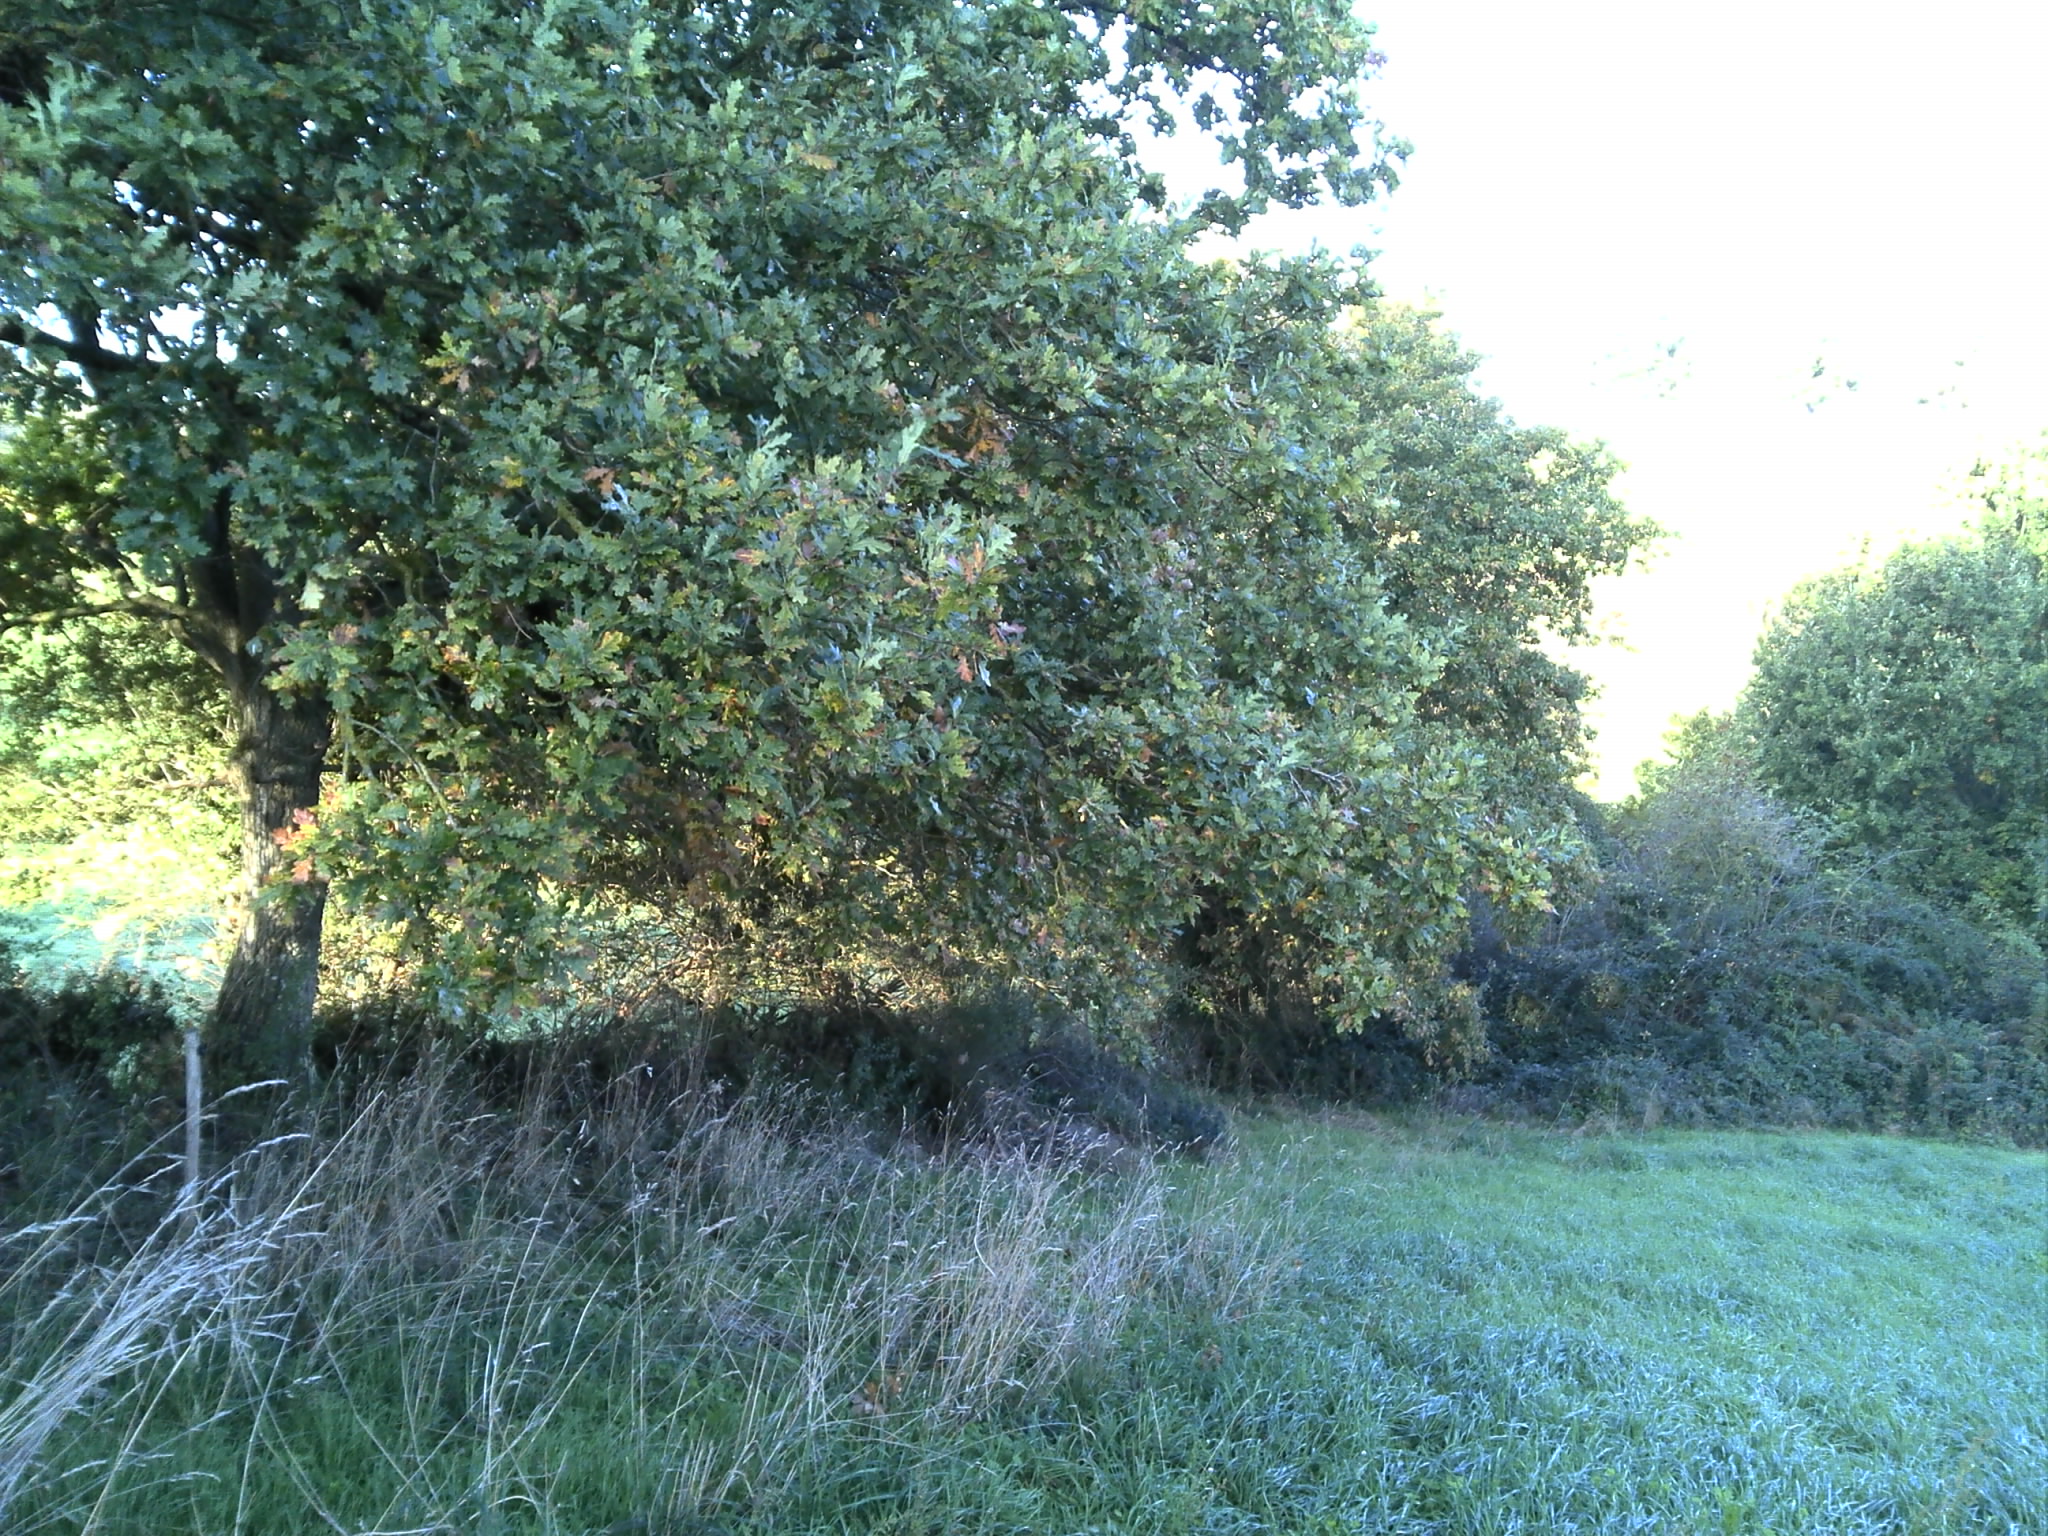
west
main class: Grassland
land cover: Grassland without tree/shrub cover
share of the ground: > 75 %
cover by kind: herbaceous plants 100 %
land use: Agriculture (excluding fallow land and kitchen gardens)
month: October
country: FR
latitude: 47.3462
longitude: -0.9825
